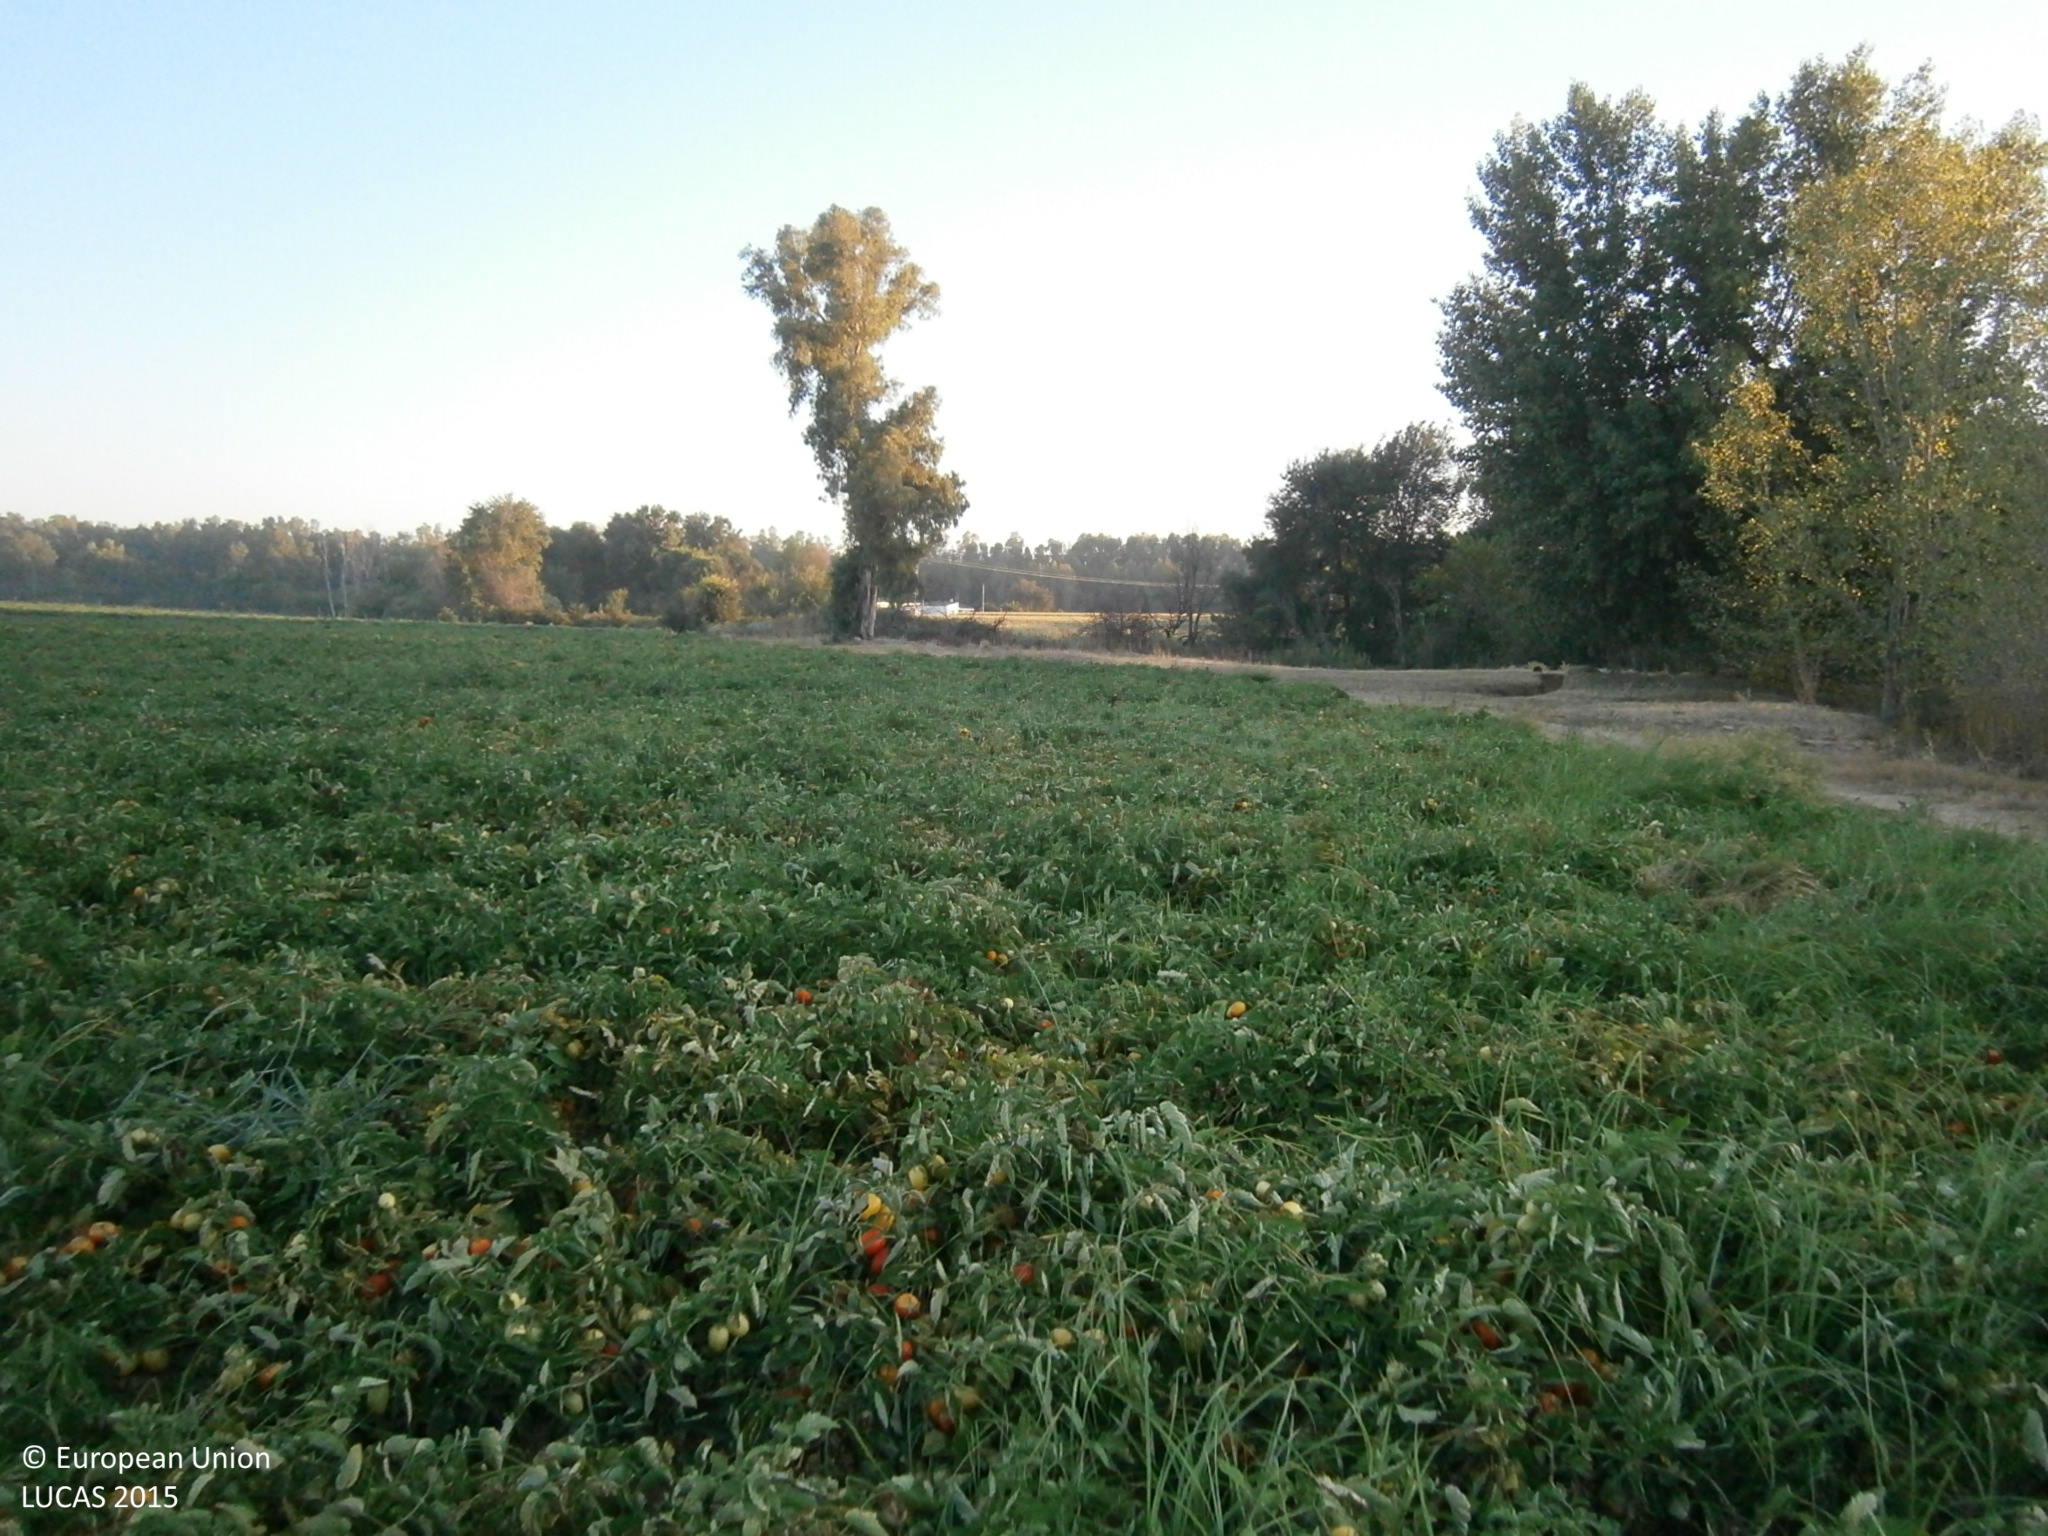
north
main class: Cropland
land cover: Tomatoes
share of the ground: > 75 %
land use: Agriculture (excluding fallow land and kitchen gardens)
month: July
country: ES
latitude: 38.9036
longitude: -6.7746
